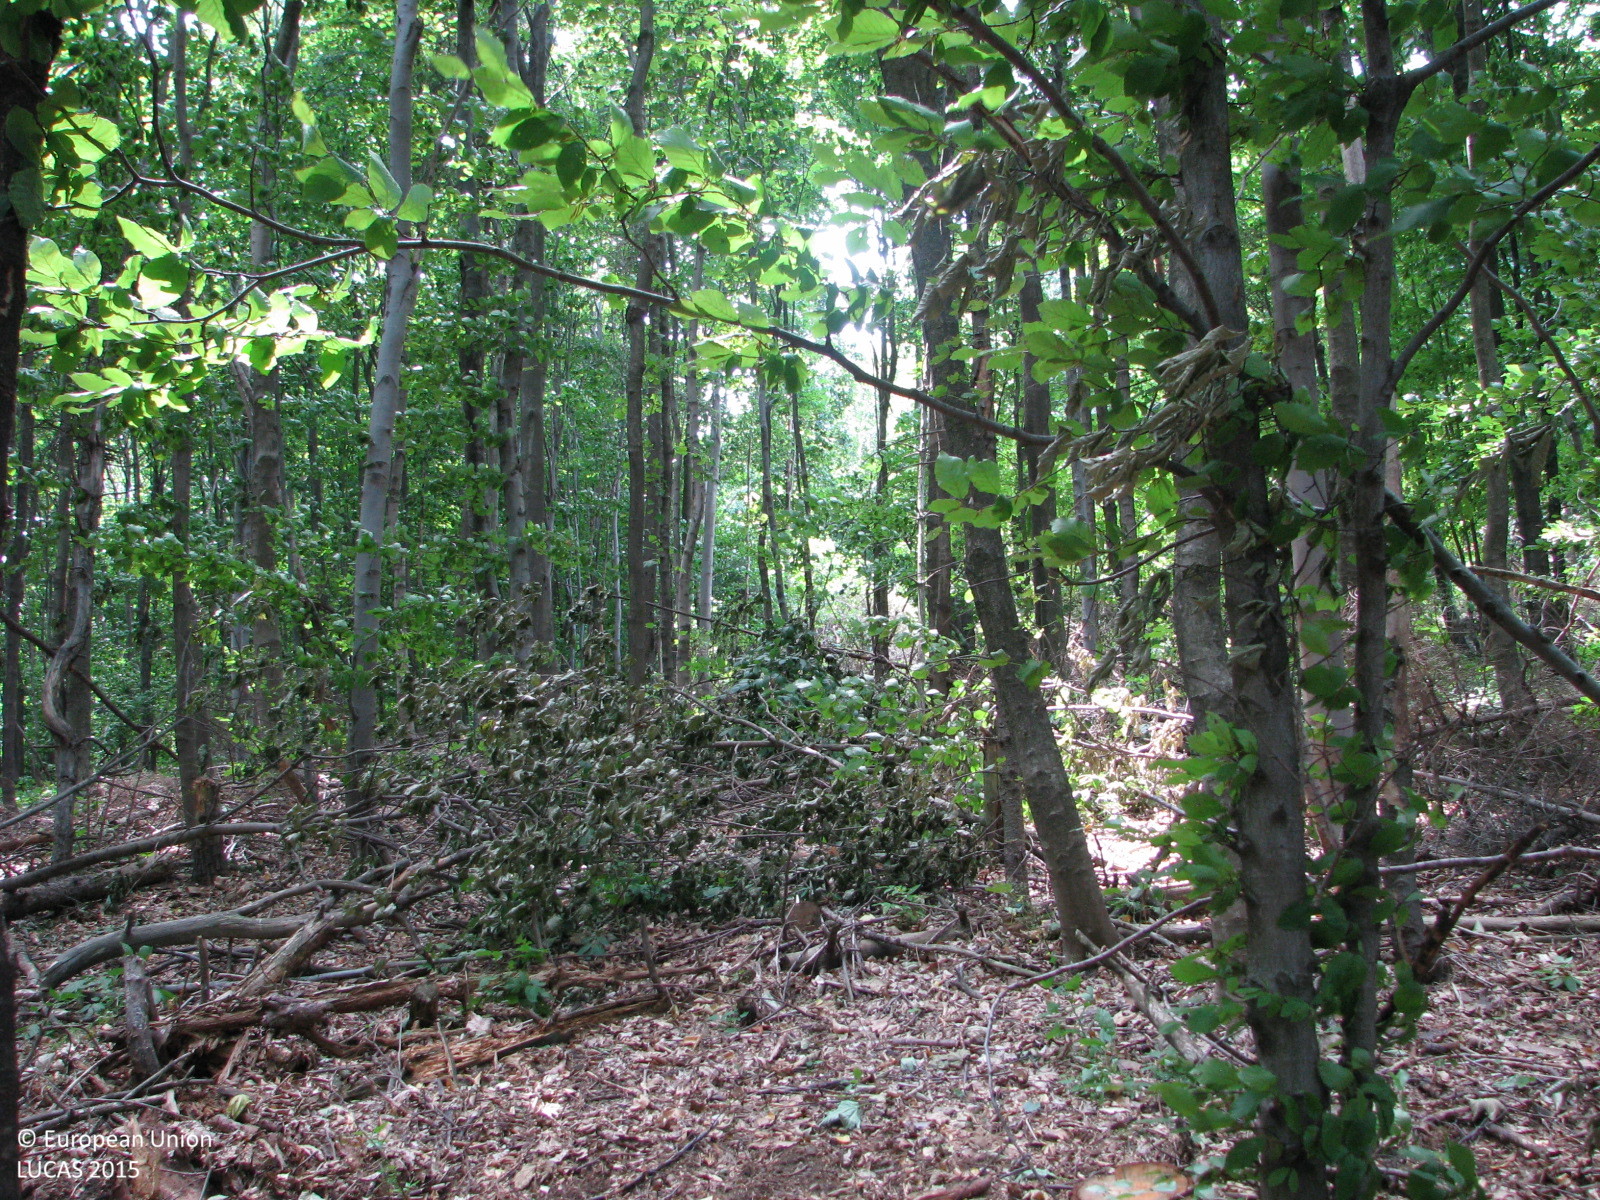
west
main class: Woodland
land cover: Broadleaved woodland
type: beech forest
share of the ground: > 75 %
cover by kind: broadleaved forest trees 75 %, unconsolidated bare surface 20 %, herbaceous plants 5 %
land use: Forestry
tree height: > 5 m
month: August
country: BG
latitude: 42.8109
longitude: 26.1951
